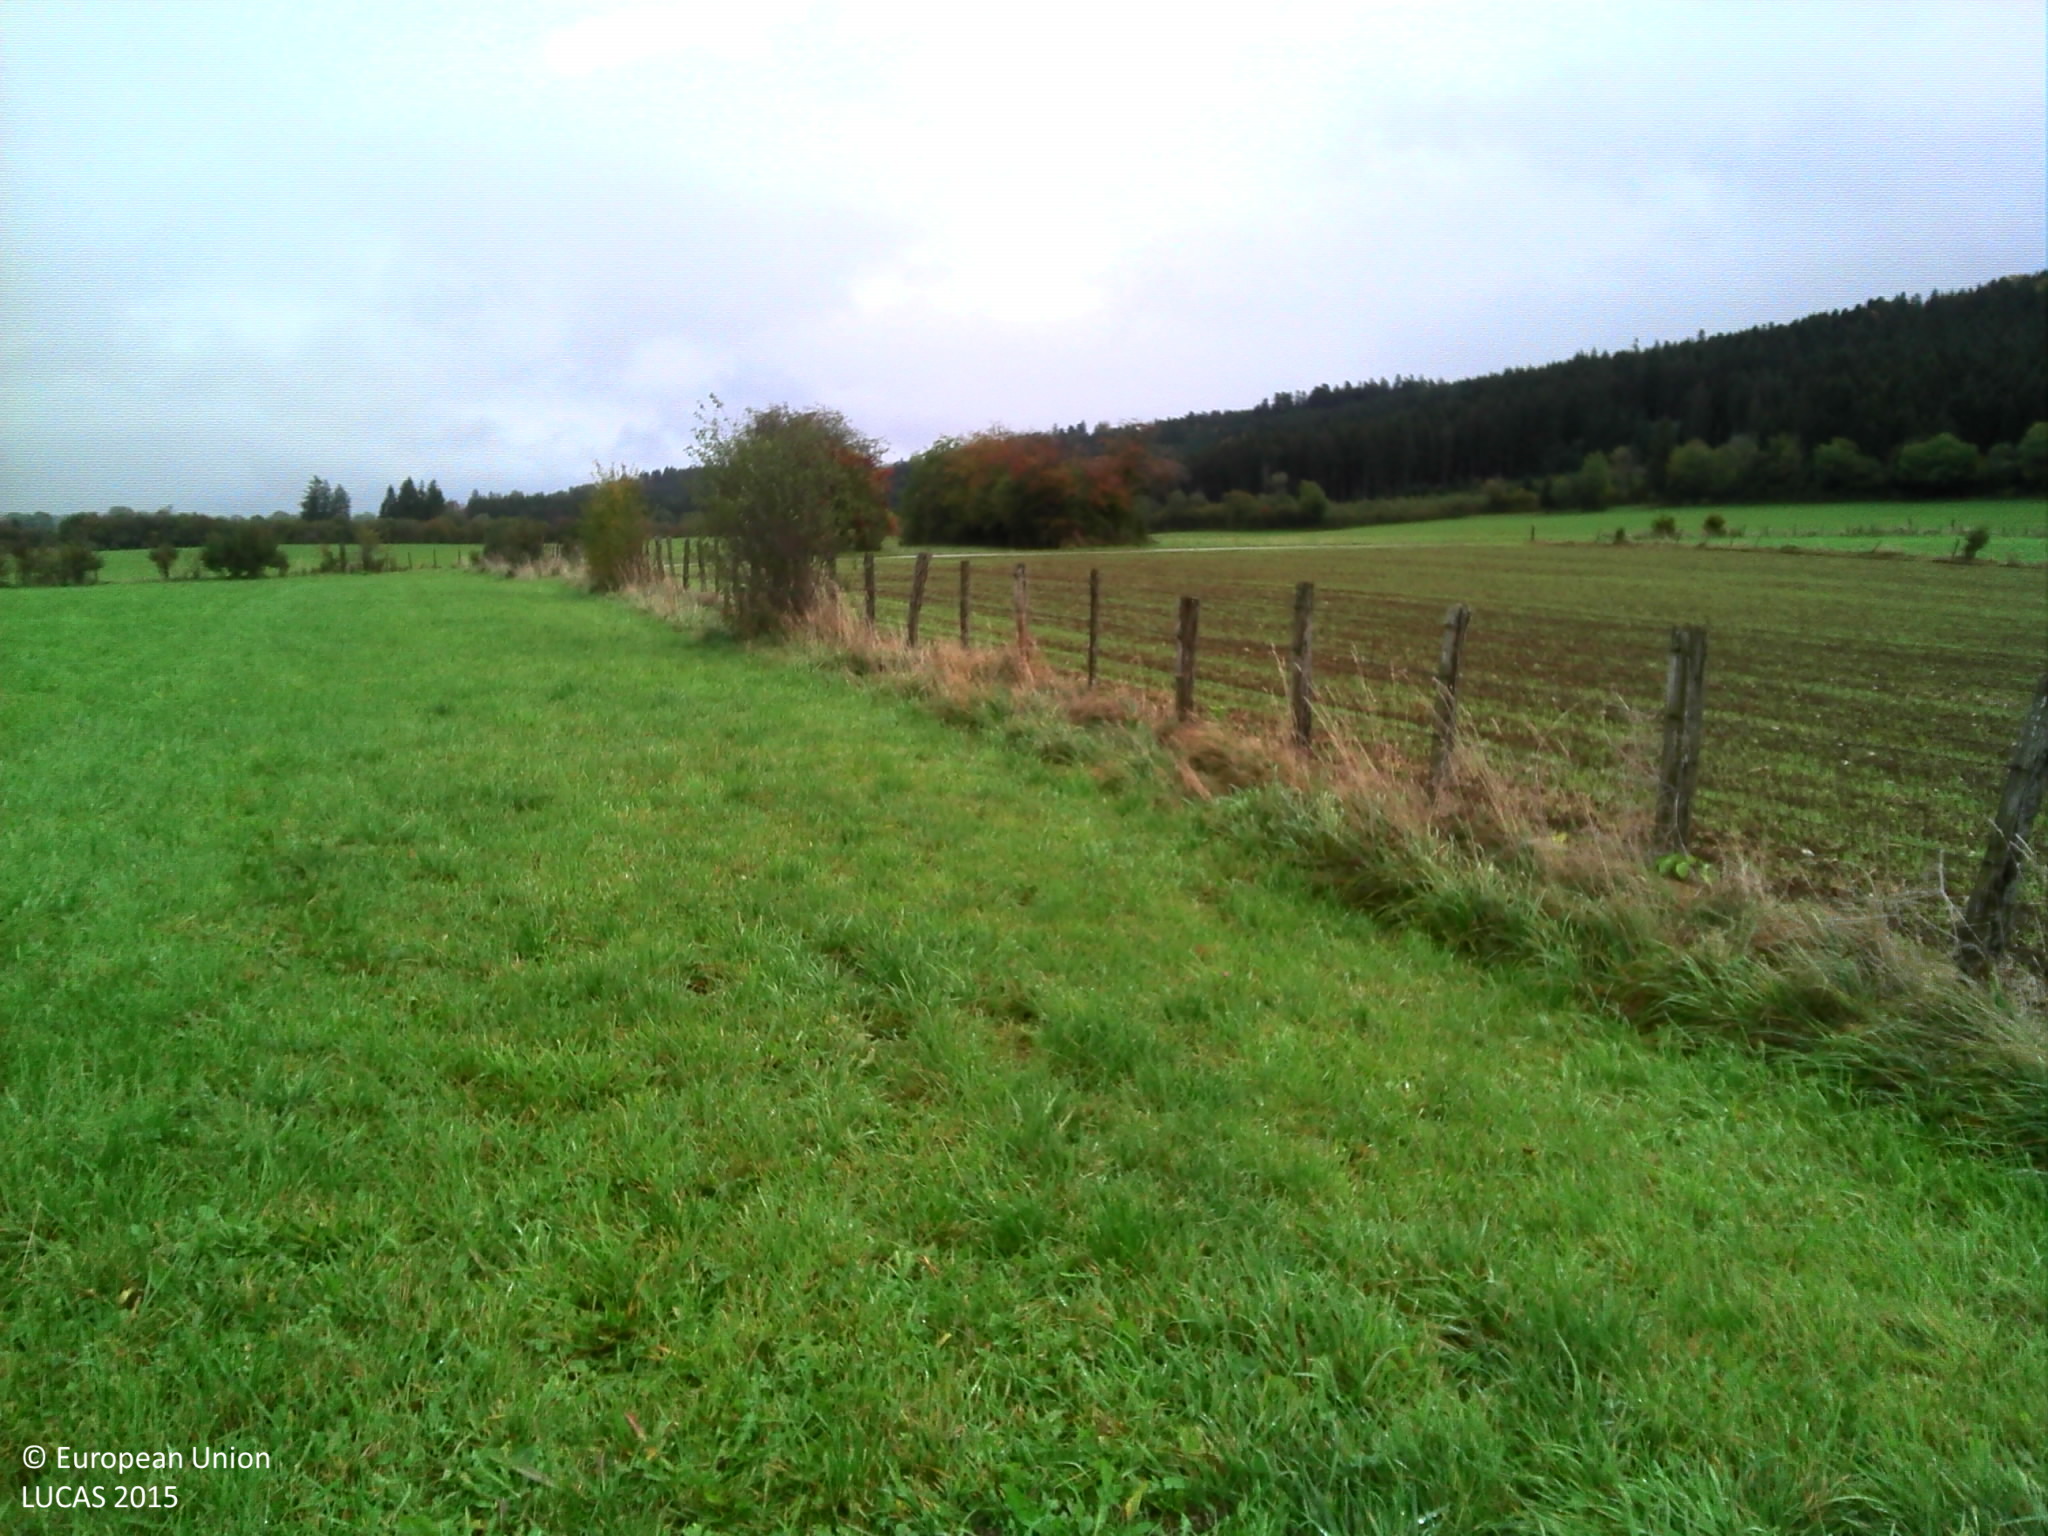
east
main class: Grassland
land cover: Grassland without tree/shrub cover
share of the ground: > 75 %
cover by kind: herbaceous plants 100 %
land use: Agriculture (excluding fallow land and kitchen gardens)
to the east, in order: Grassland without tree/shrub cover; Fences; Common wheat; Grass margins; Paved roads, cycling and walking lanes; Fences; Grassland without tree/shrub cover
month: October
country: FR
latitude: 46.9481
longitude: 6.1264
